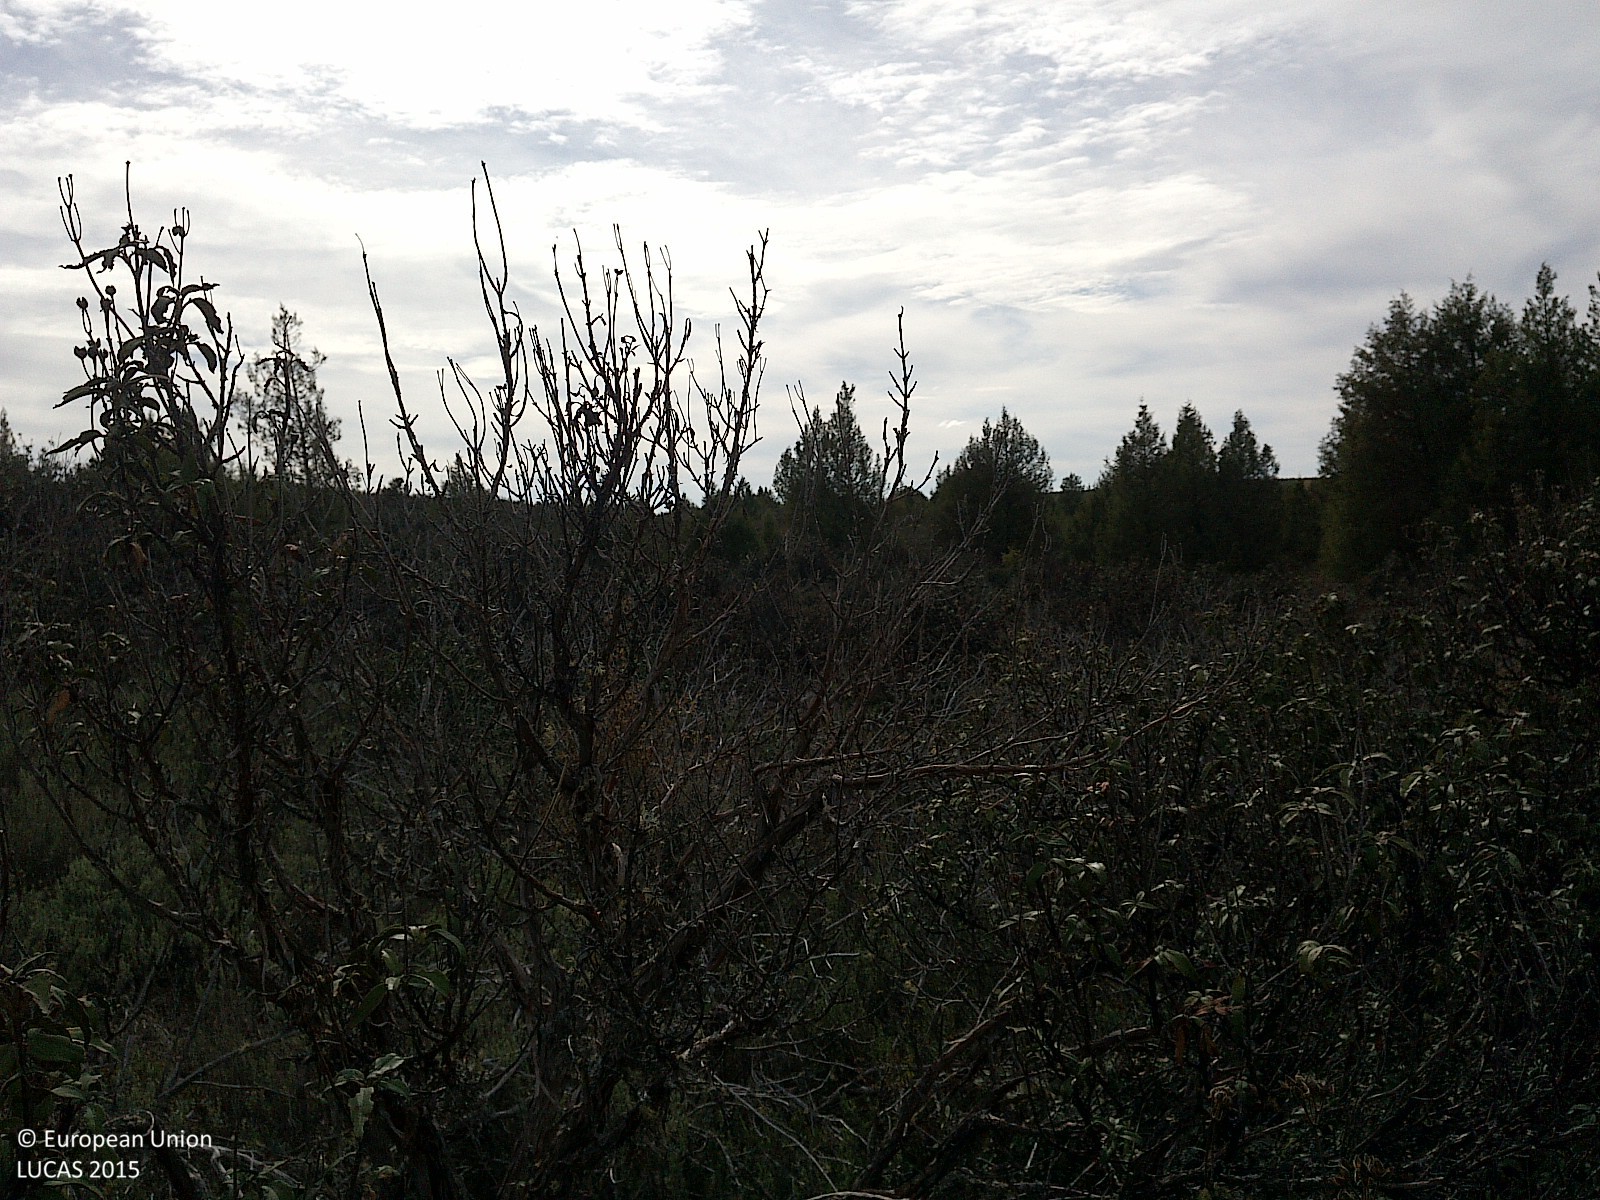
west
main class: Shrubland
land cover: Shrubland with sparse tree cover
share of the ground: 50 - 75 %
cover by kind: shrubs 65 %, herbaceous plants 20 %, unconsolidated bare surface 10 %, coniferous forest trees 5 %
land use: Semi-natural and natural areas not in use
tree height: > 5 m
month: April
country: ES
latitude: 41.7276
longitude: -3.0886
